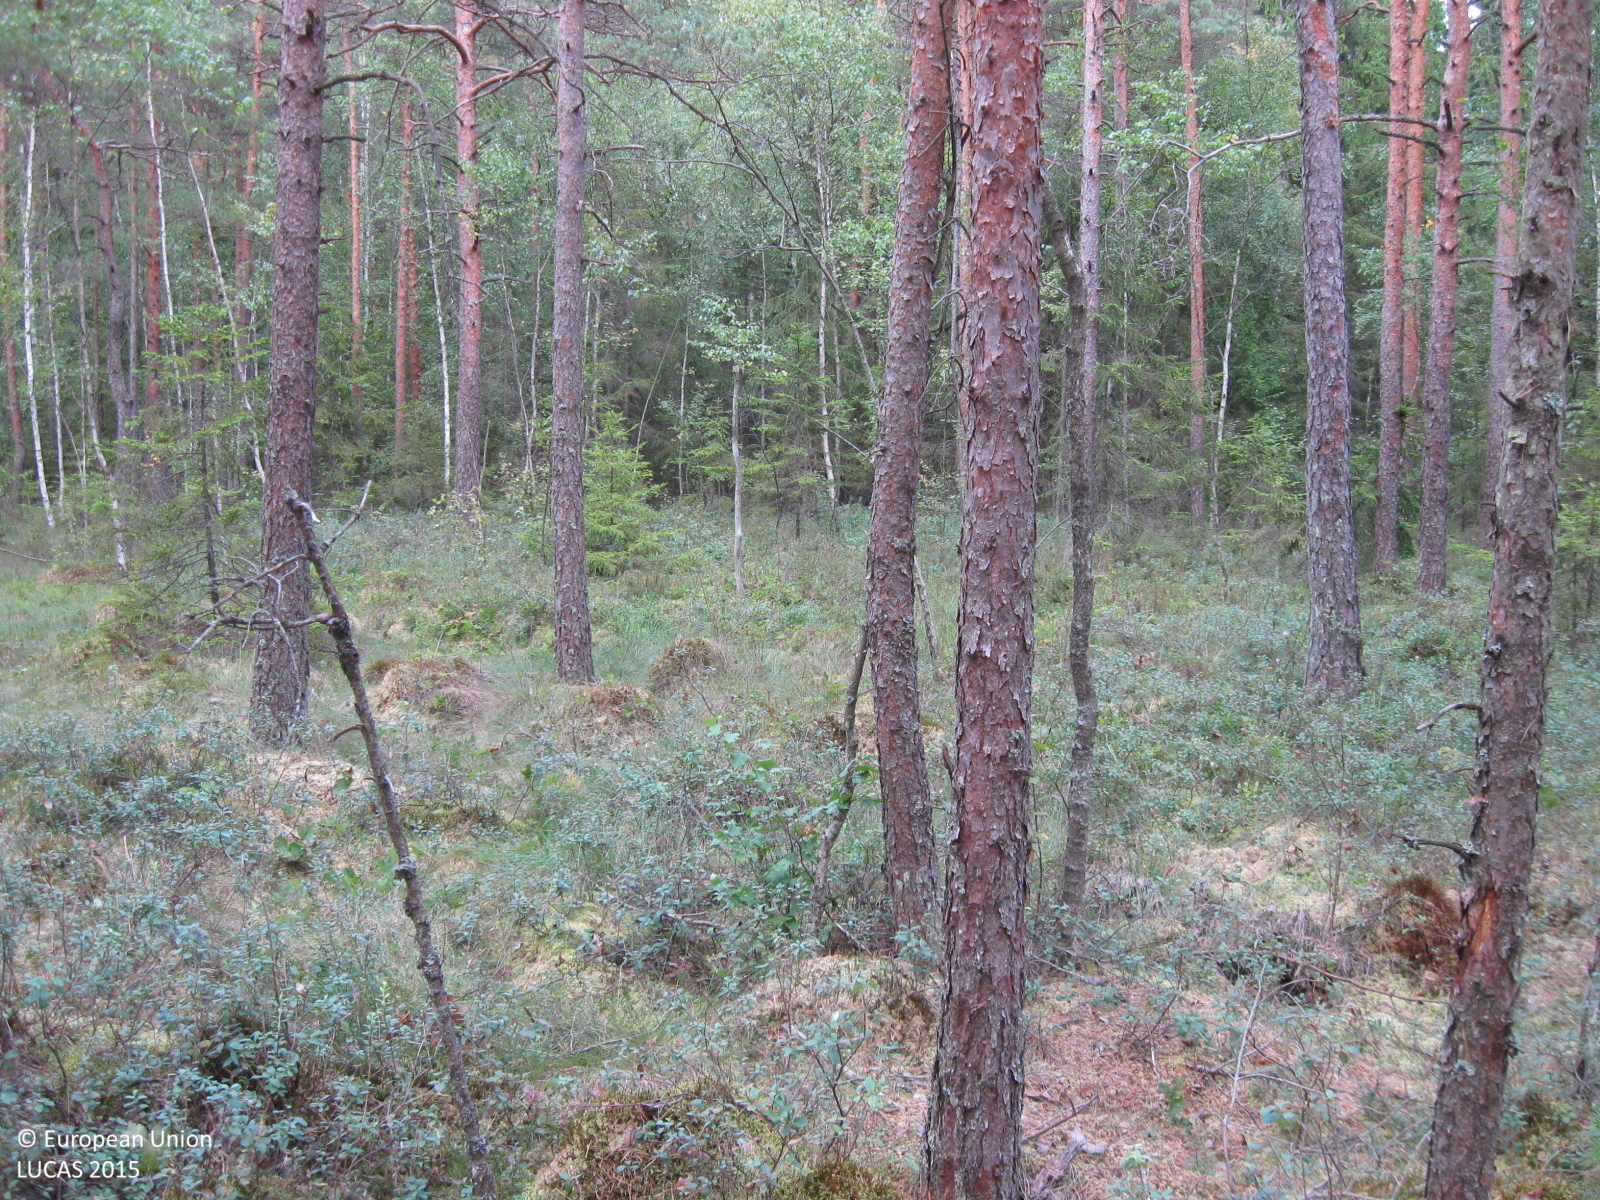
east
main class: Woodland
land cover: Pine dominated coniferous woodland
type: mire and swamp forests
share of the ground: > 75 %
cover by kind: coniferous forest trees 75 %, herbaceous plants 10 %, lichens and mosses 10 %, broadleaved forest trees 5 %
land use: Forestry
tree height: > 5 m
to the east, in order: Pine dominated coniferous woodland; Other structural elements; Other mixed woodland; Tracks; Other mixed woodland; Pine dominated mixed woodland; Pine dominated coniferous woodland
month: August
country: LT
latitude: 55.5594
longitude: 23.3462
